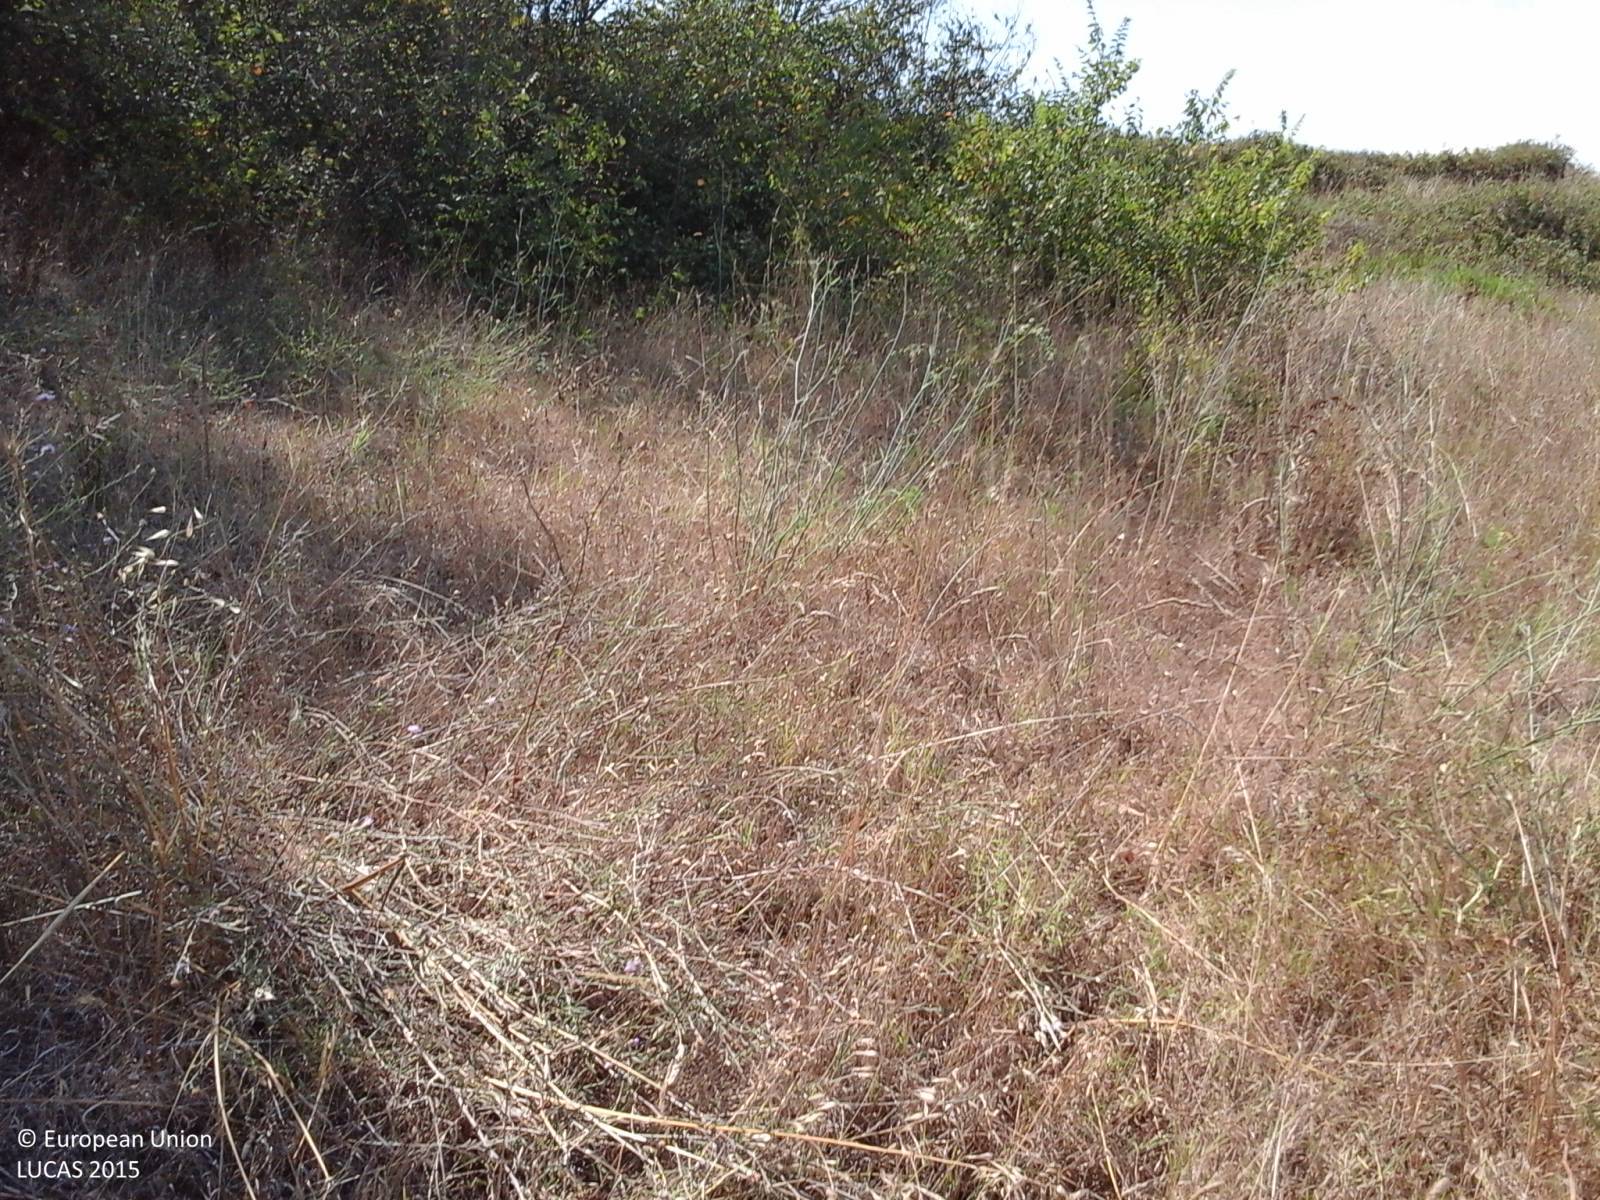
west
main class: Grassland
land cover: Grassland without tree/shrub cover
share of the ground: > 75 %
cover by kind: herbaceous plants 100 %
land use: Agriculture (excluding fallow land and kitchen gardens)
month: August
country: IT
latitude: 42.0688
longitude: 12.2518
